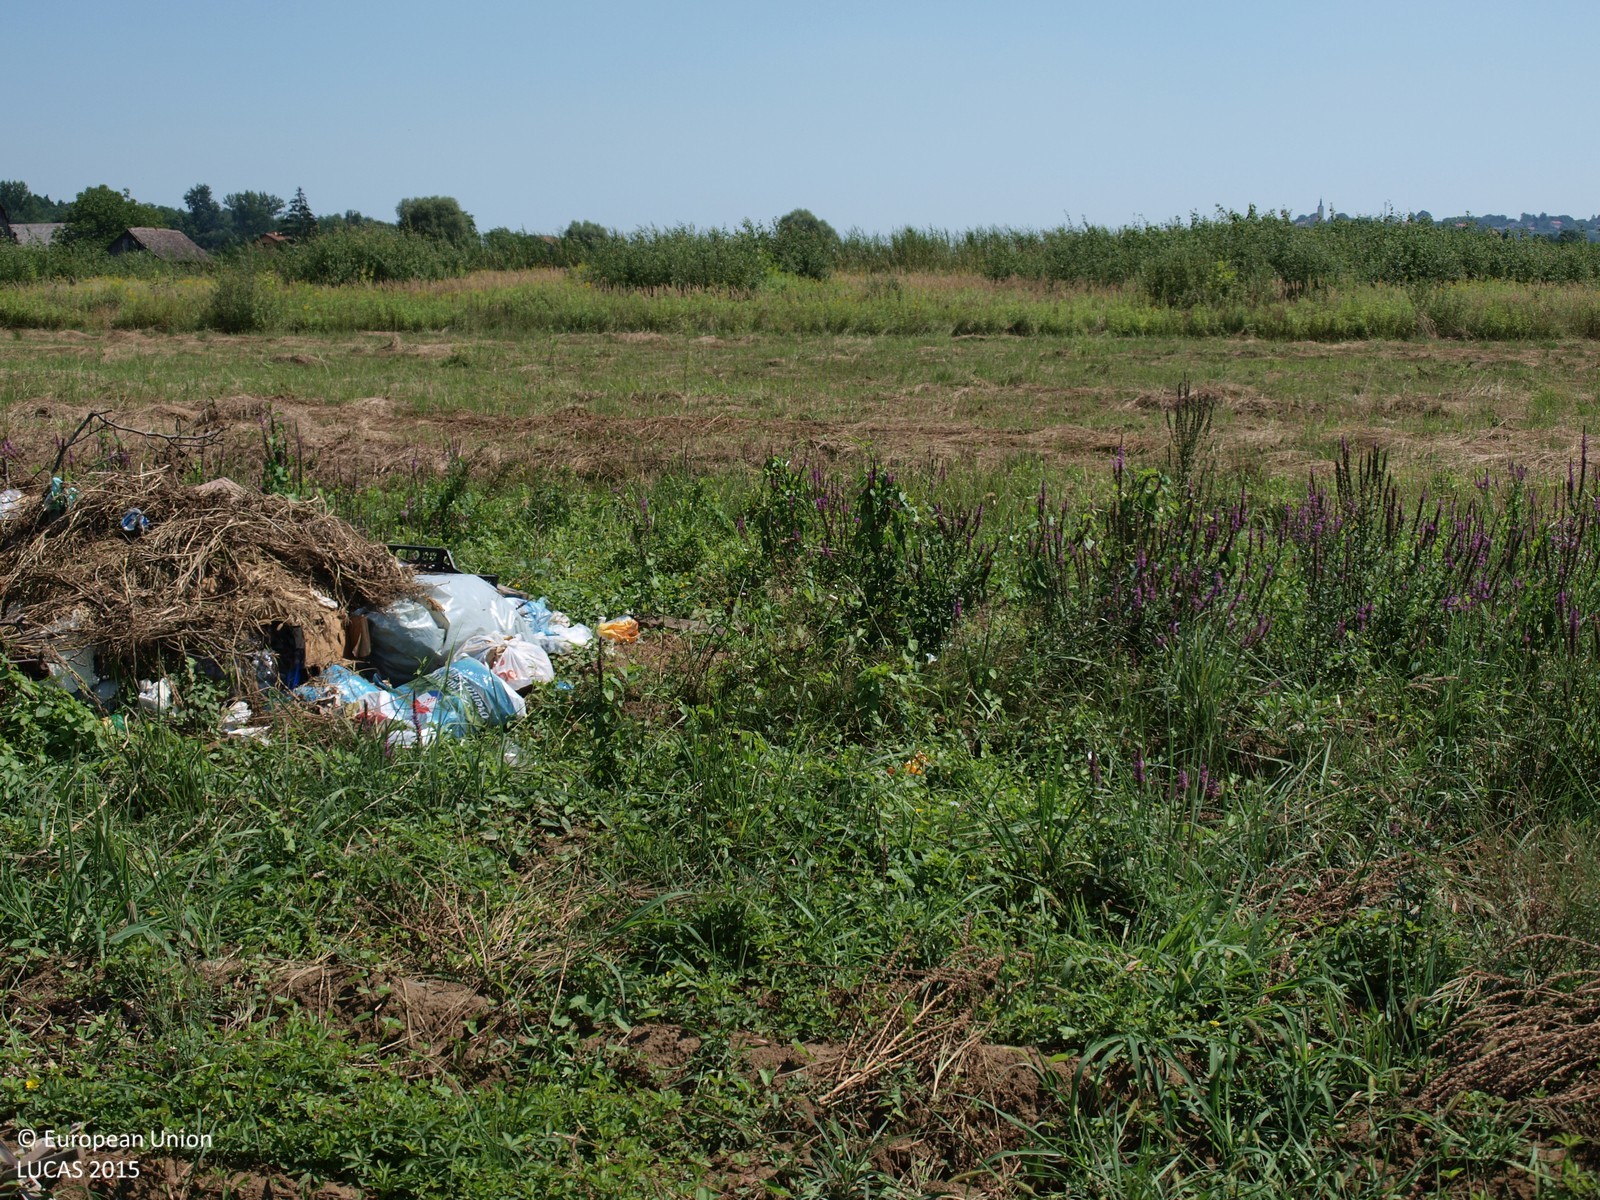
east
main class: Cropland
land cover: Other root crops
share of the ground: > 75 %
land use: Kitchen garden
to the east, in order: Other root crops; Grassland without tree/shrub cover; Shrubland without tree cover; Grassland without tree/shrub cover
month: August
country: HR
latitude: 45.8421
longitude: 16.2692
